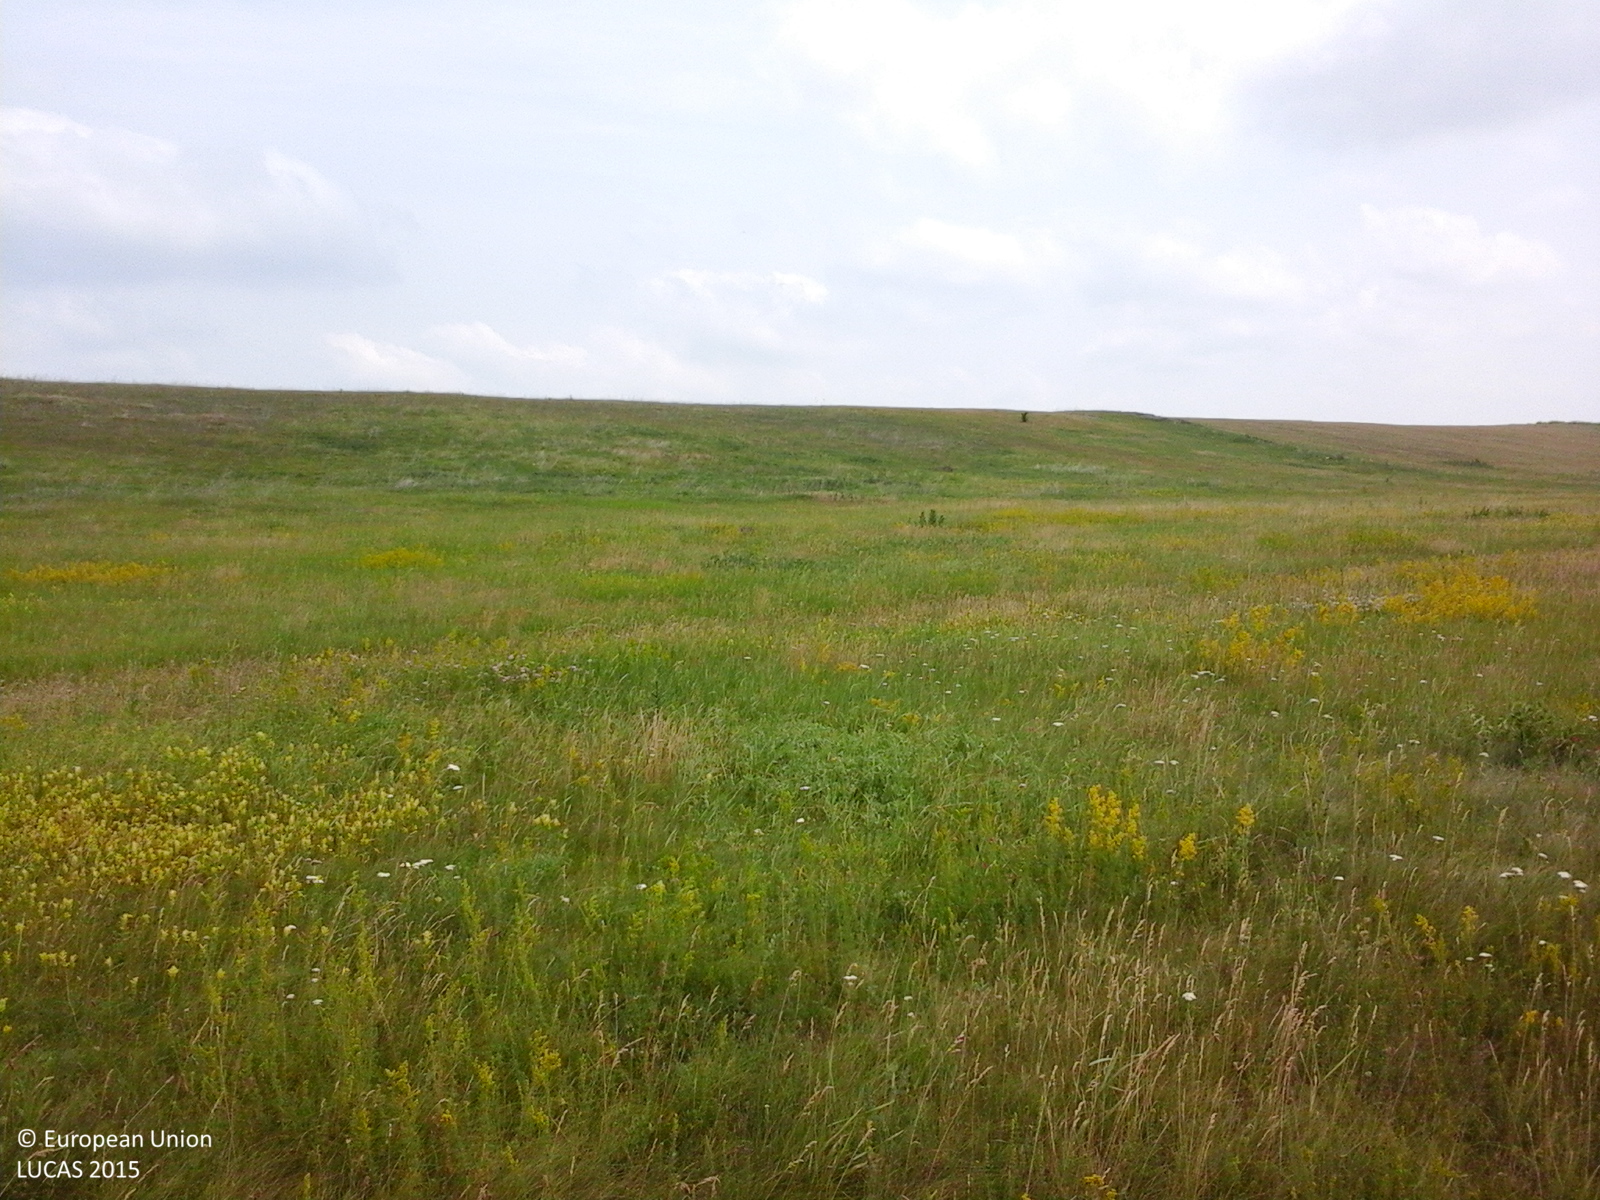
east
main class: Grassland
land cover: Grassland without tree/shrub cover
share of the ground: > 75 %
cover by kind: herbaceous plants 100 %
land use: Agriculture (excluding fallow land and kitchen gardens)
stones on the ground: < 10 %
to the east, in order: Grassland without tree/shrub cover; Tracks; Grassland without tree/shrub cover
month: June
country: RO
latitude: 48.0362
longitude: 26.6053
